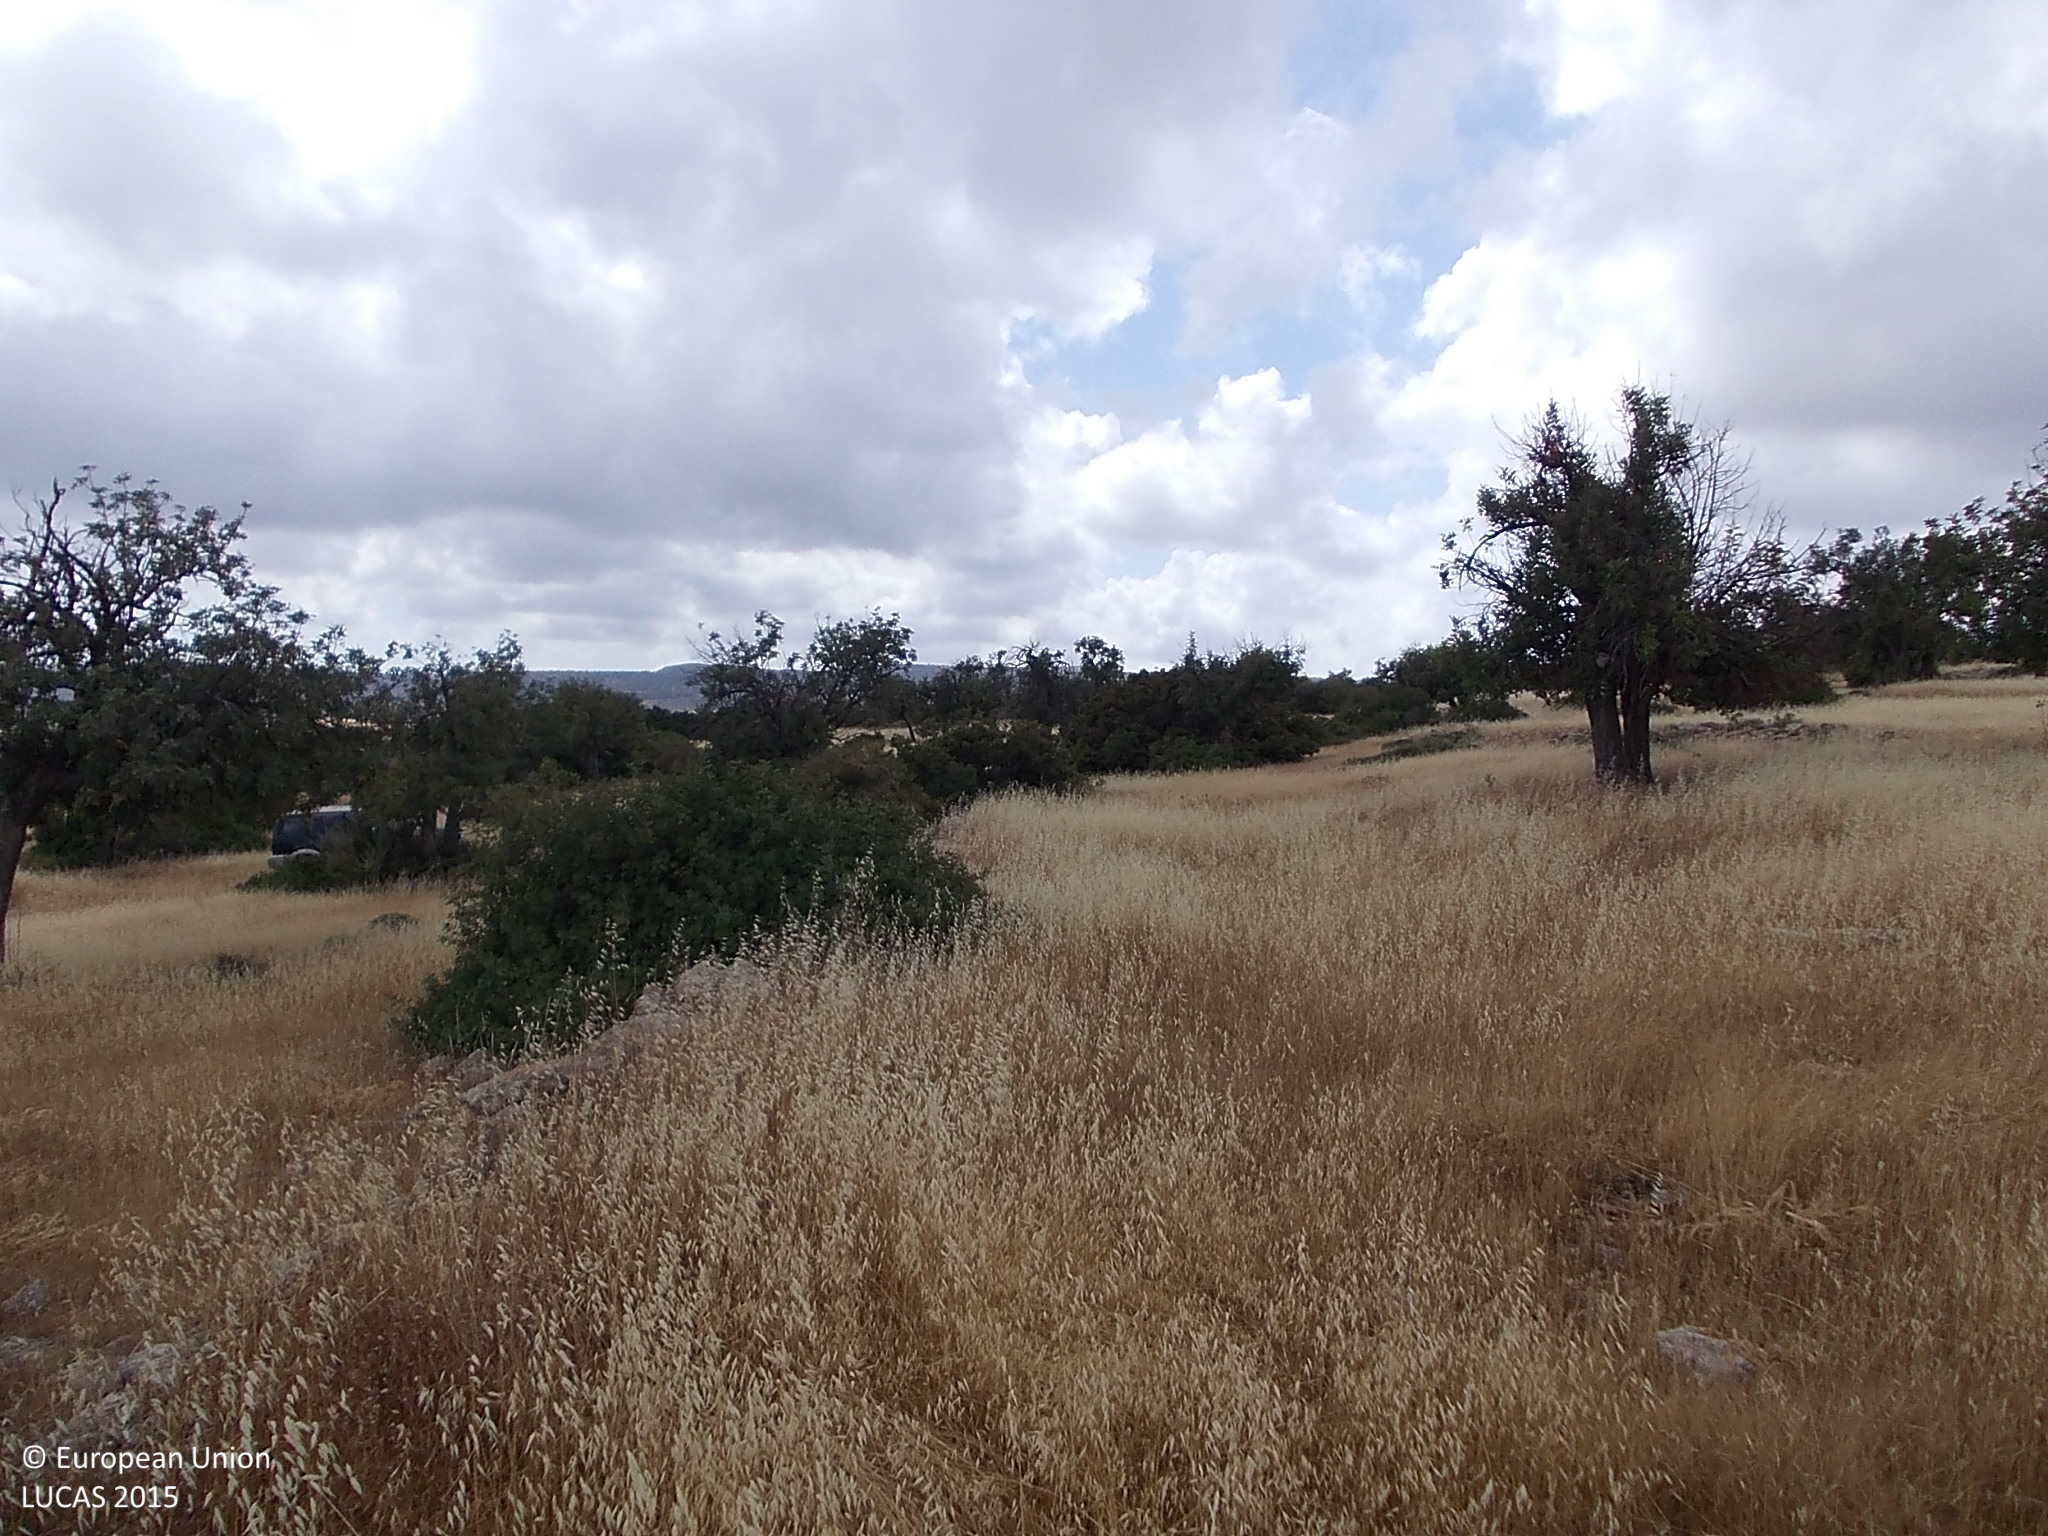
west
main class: Grassland
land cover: Grassland with sparse tree/shrub cover
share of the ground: > 75 %
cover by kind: herbaceous plants 85 %, coniferous forest trees 5 %, shrubs 5 %, consolidated bare surface 5 %
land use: Semi-natural and natural areas not in use
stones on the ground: 10 - 25 %
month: May
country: CY
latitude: 34.7211
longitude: 32.7707
